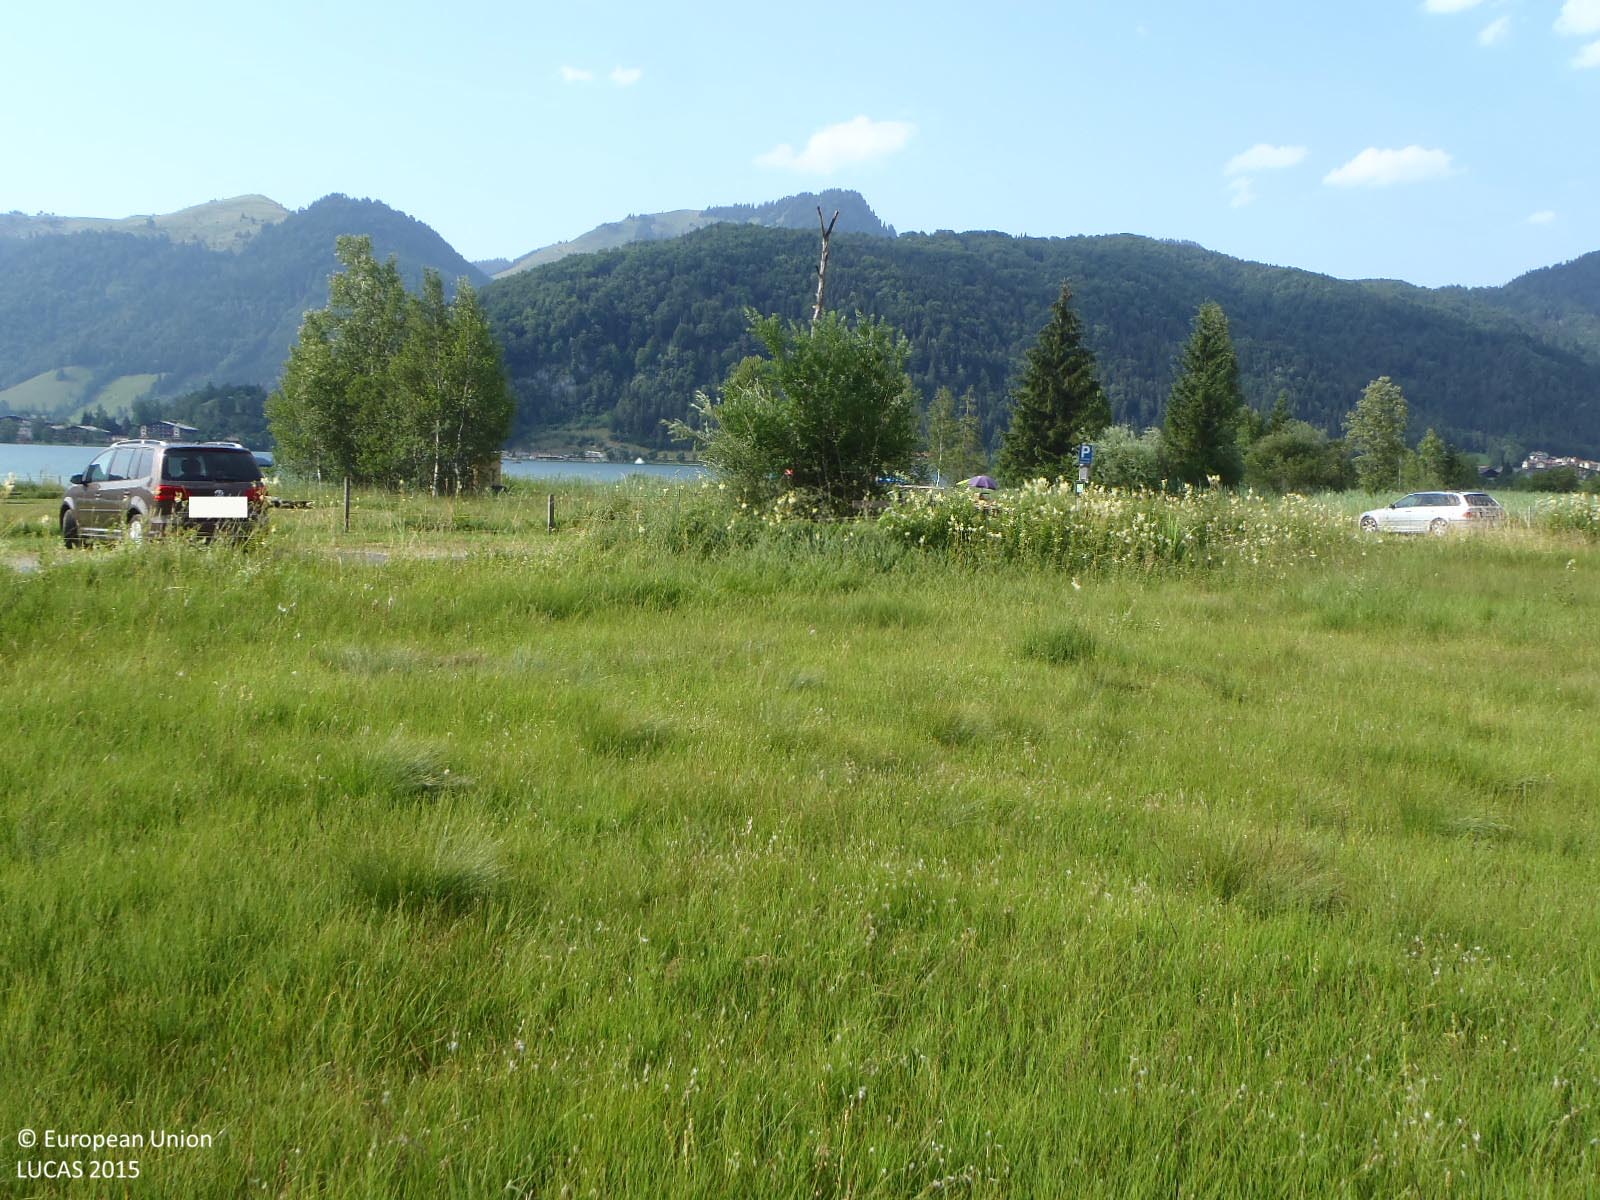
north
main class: Grassland
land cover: Grassland without tree/shrub cover
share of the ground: > 75 %
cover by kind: herbaceous plants 70 %, lichens and mosses 30 %
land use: Agriculture (excluding fallow land and kitchen gardens)
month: July
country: AT
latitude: 47.6408
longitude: 12.3279
